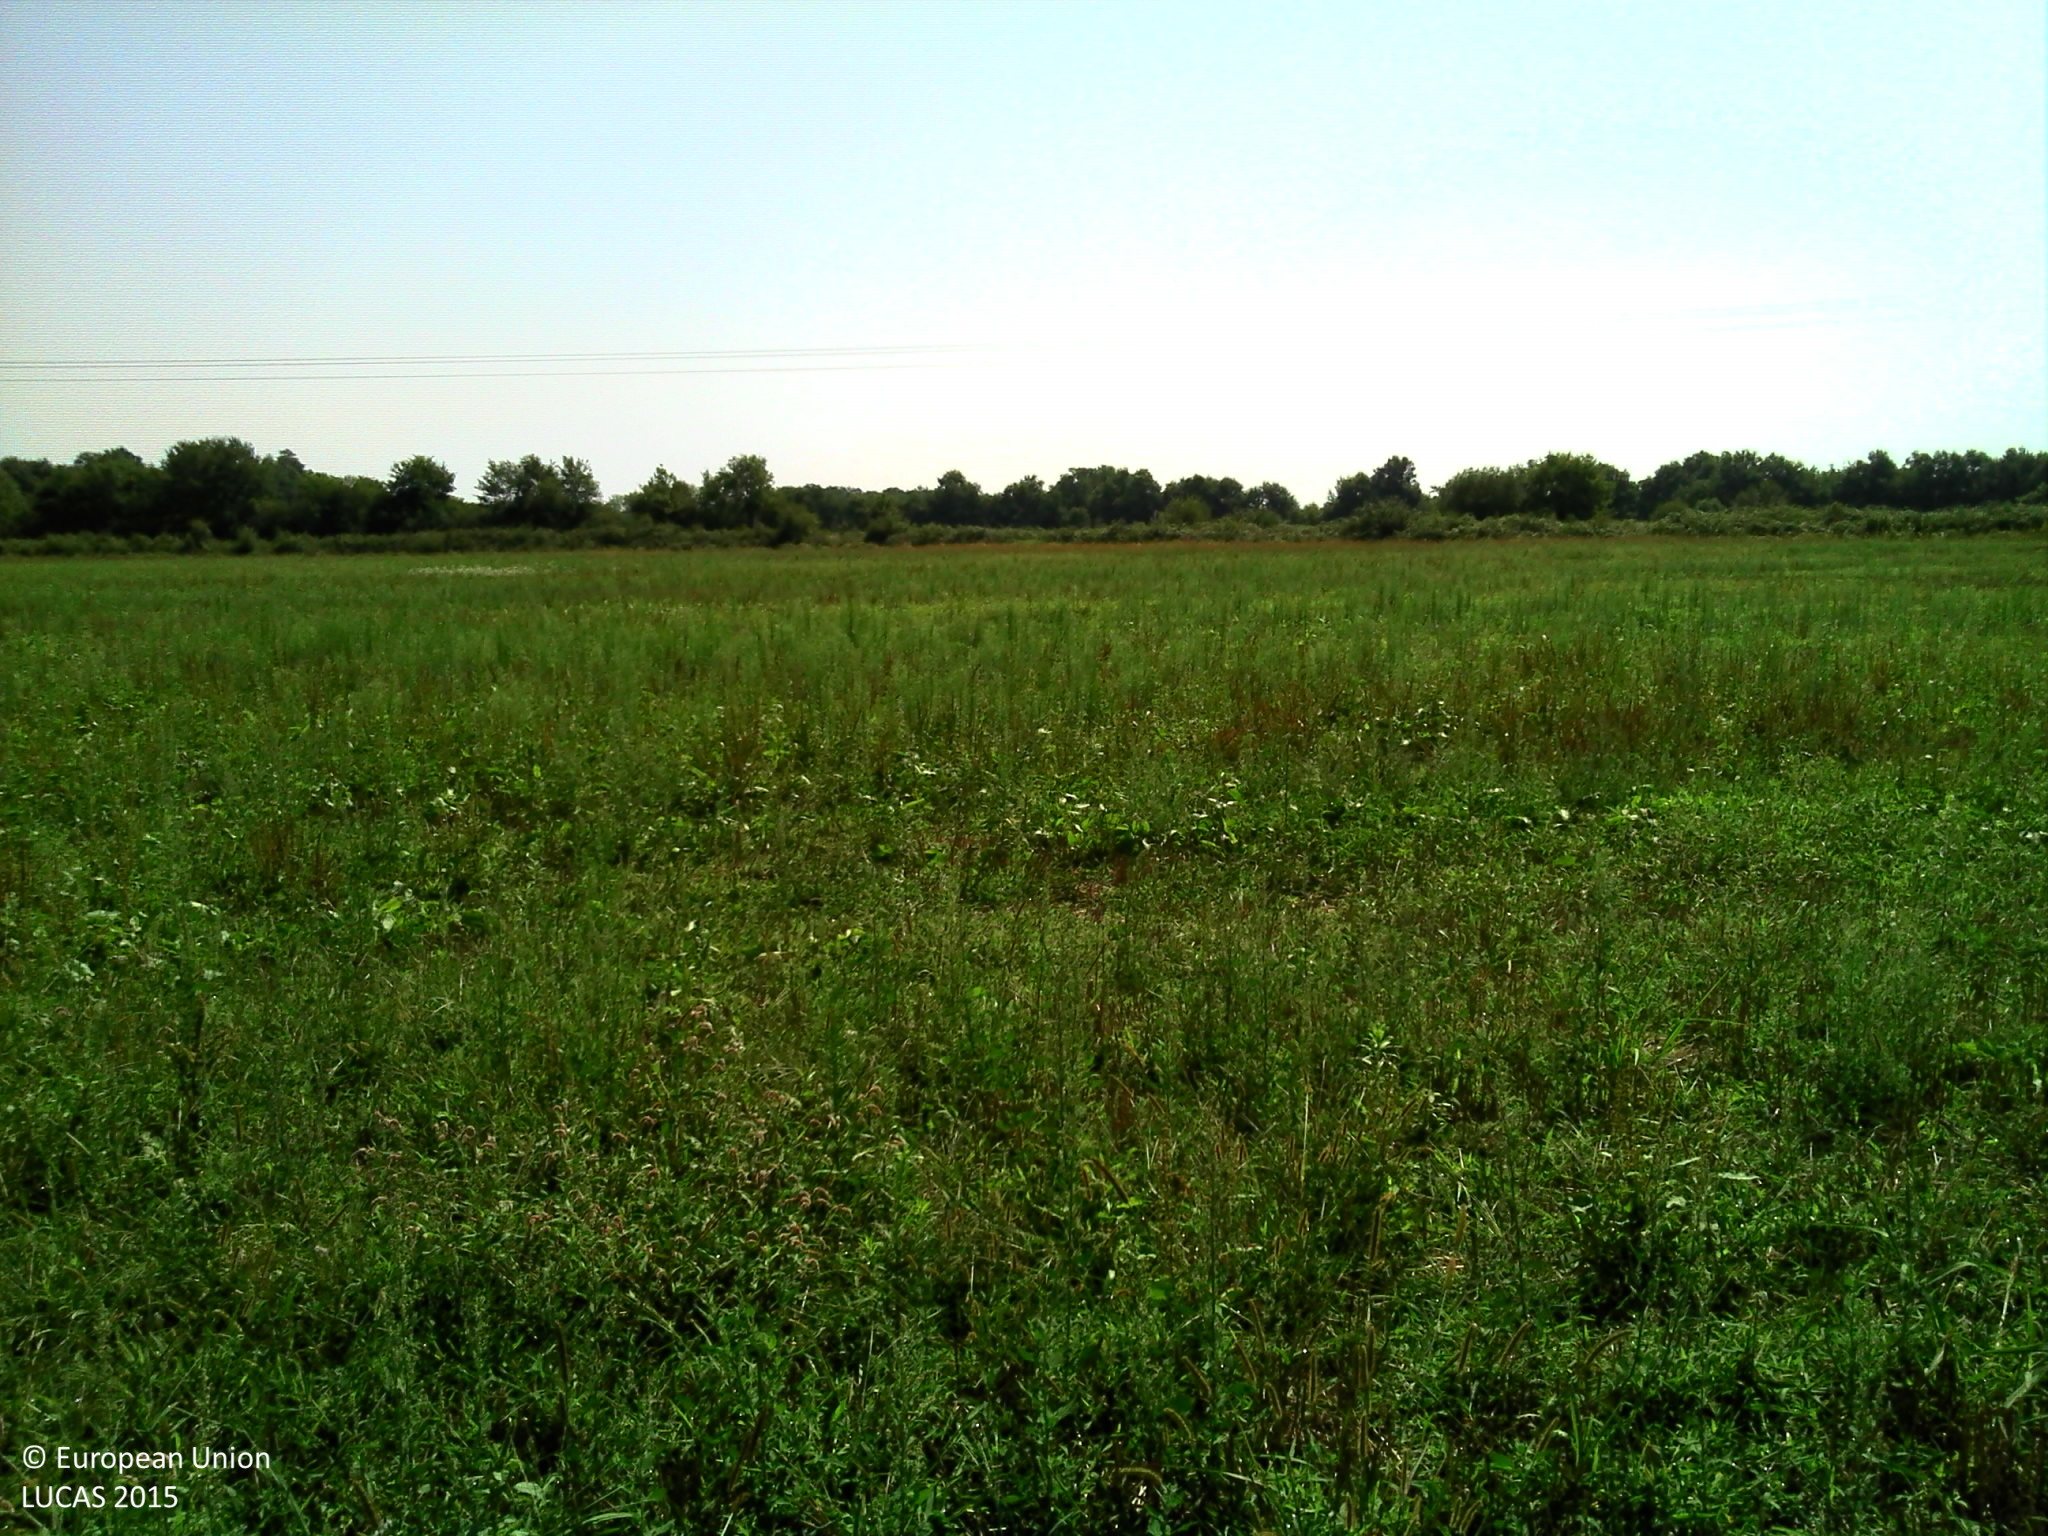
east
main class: Cropland
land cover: Temporary grasslands
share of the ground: > 75 %
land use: Agriculture (excluding fallow land and kitchen gardens)
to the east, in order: Temporary grasslands; Electric lines; Temporary grasslands; Ditches and canals; Abandoned hedges; Grassland without tree/shrub cover; Abandoned hedges; Grassland without tree/shrub cover; Shrubland without tree cover
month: August
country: FR
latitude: 43.7968
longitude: -0.5135
